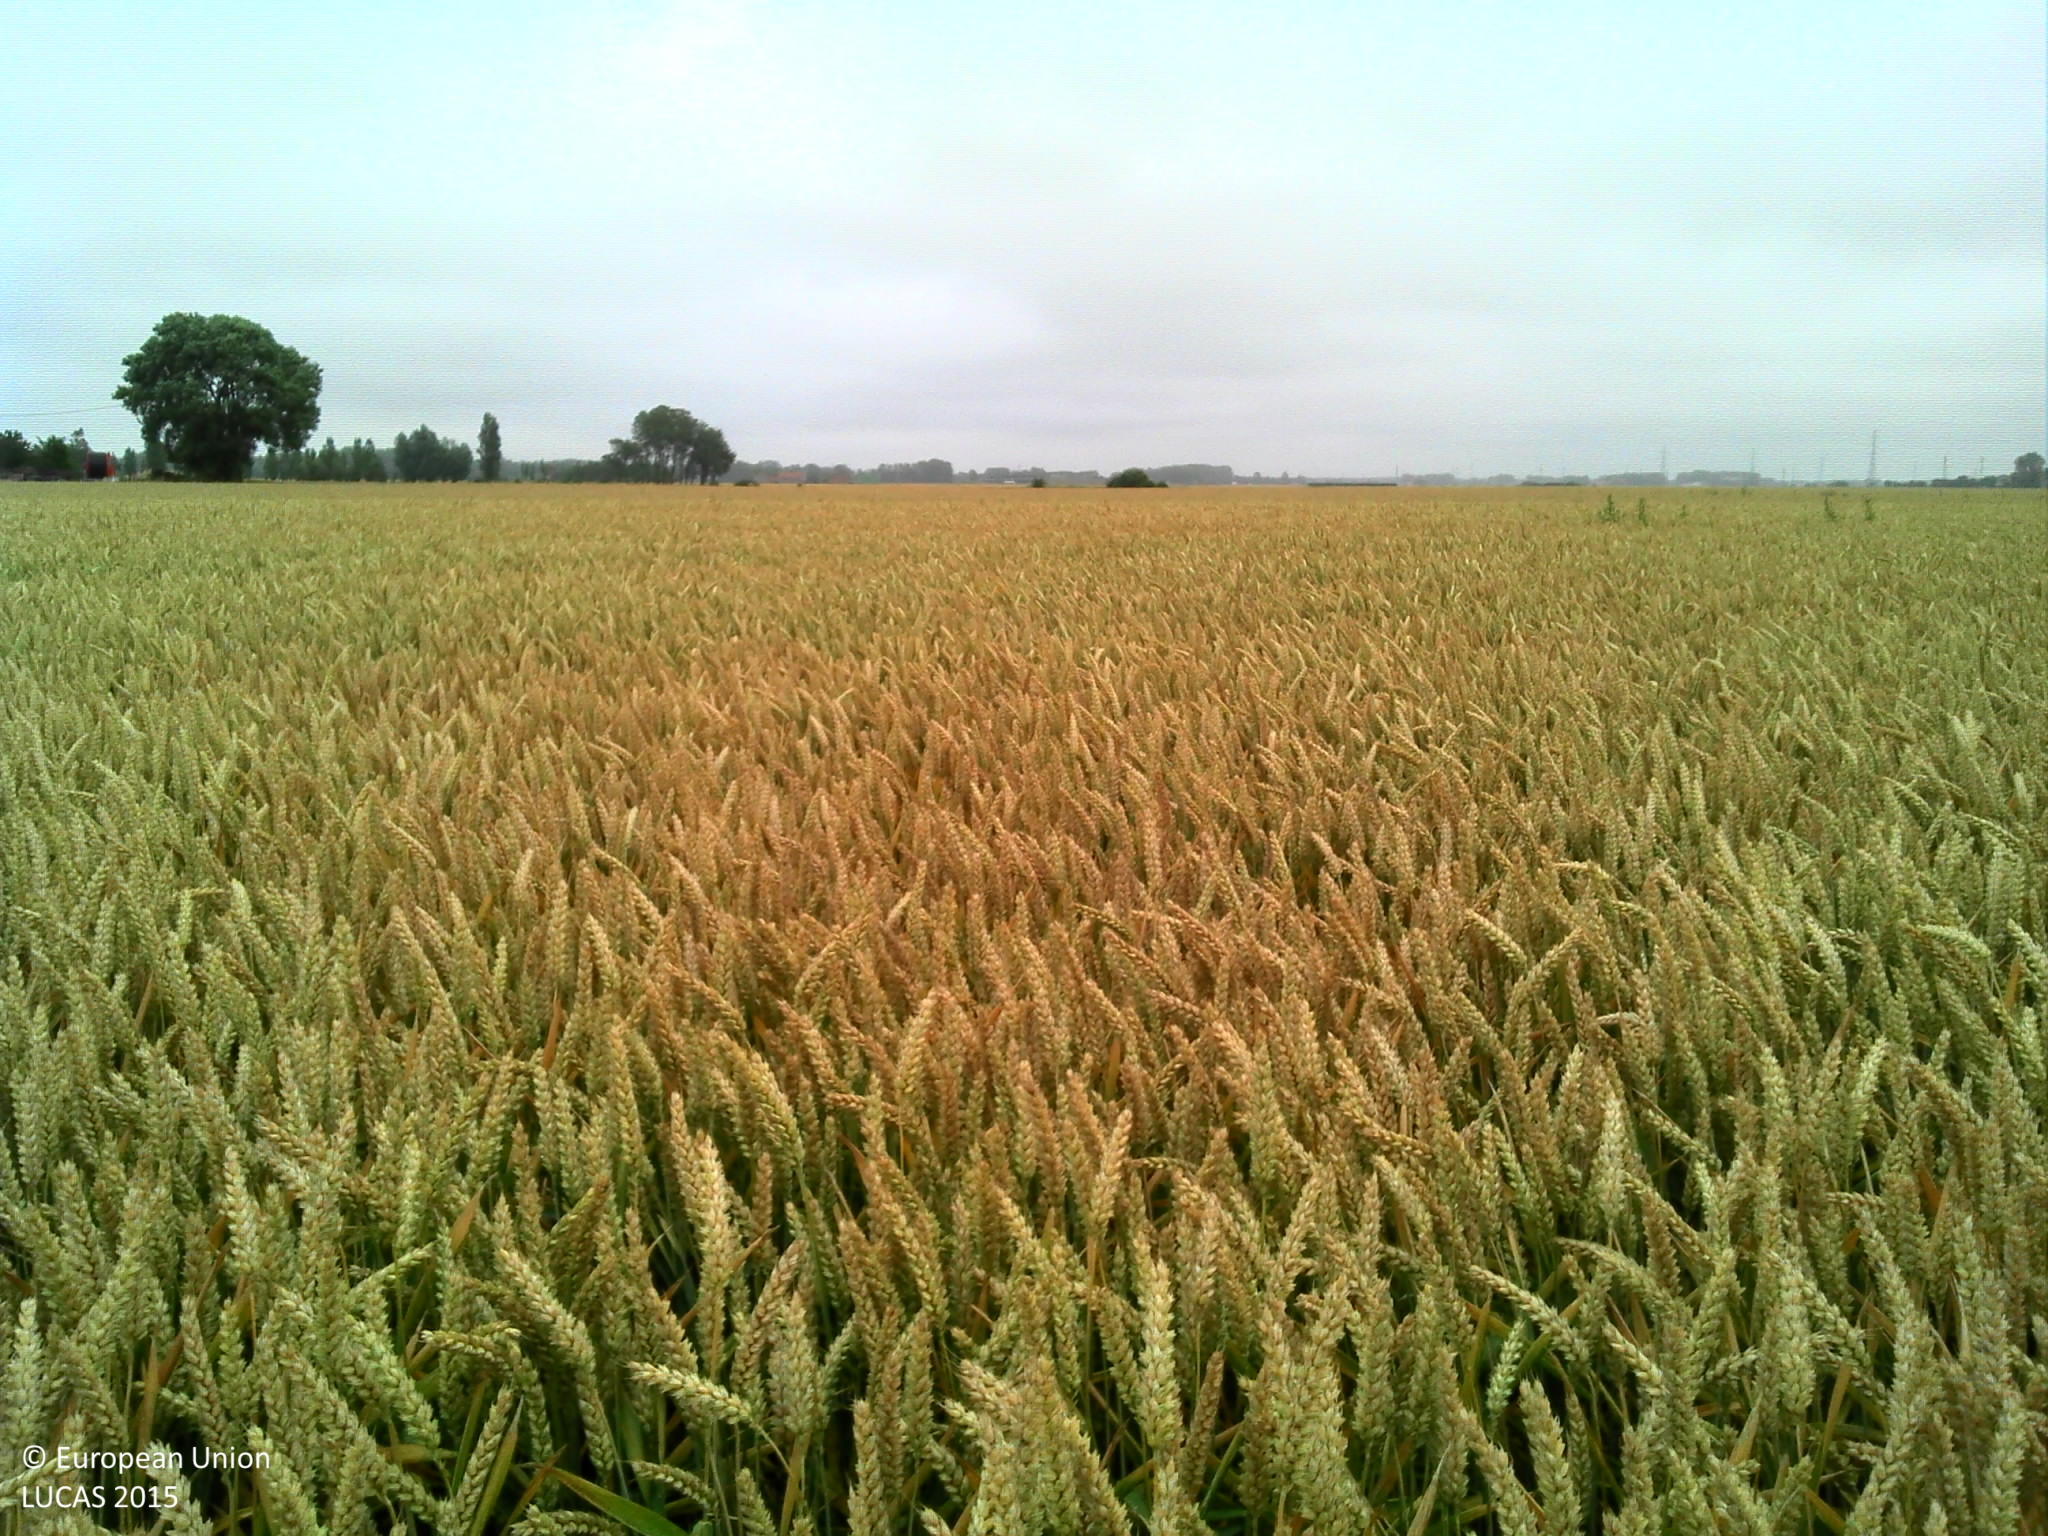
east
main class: Cropland
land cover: Common wheat
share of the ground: > 75 %
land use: Agriculture (excluding fallow land and kitchen gardens)
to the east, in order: Common wheat; Grass margins; Ditches and canals; Grass margins; Common wheat; Grass margins; Tracks; Other bare soil
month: July
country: FR
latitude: 50.9899
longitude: 2.3071
